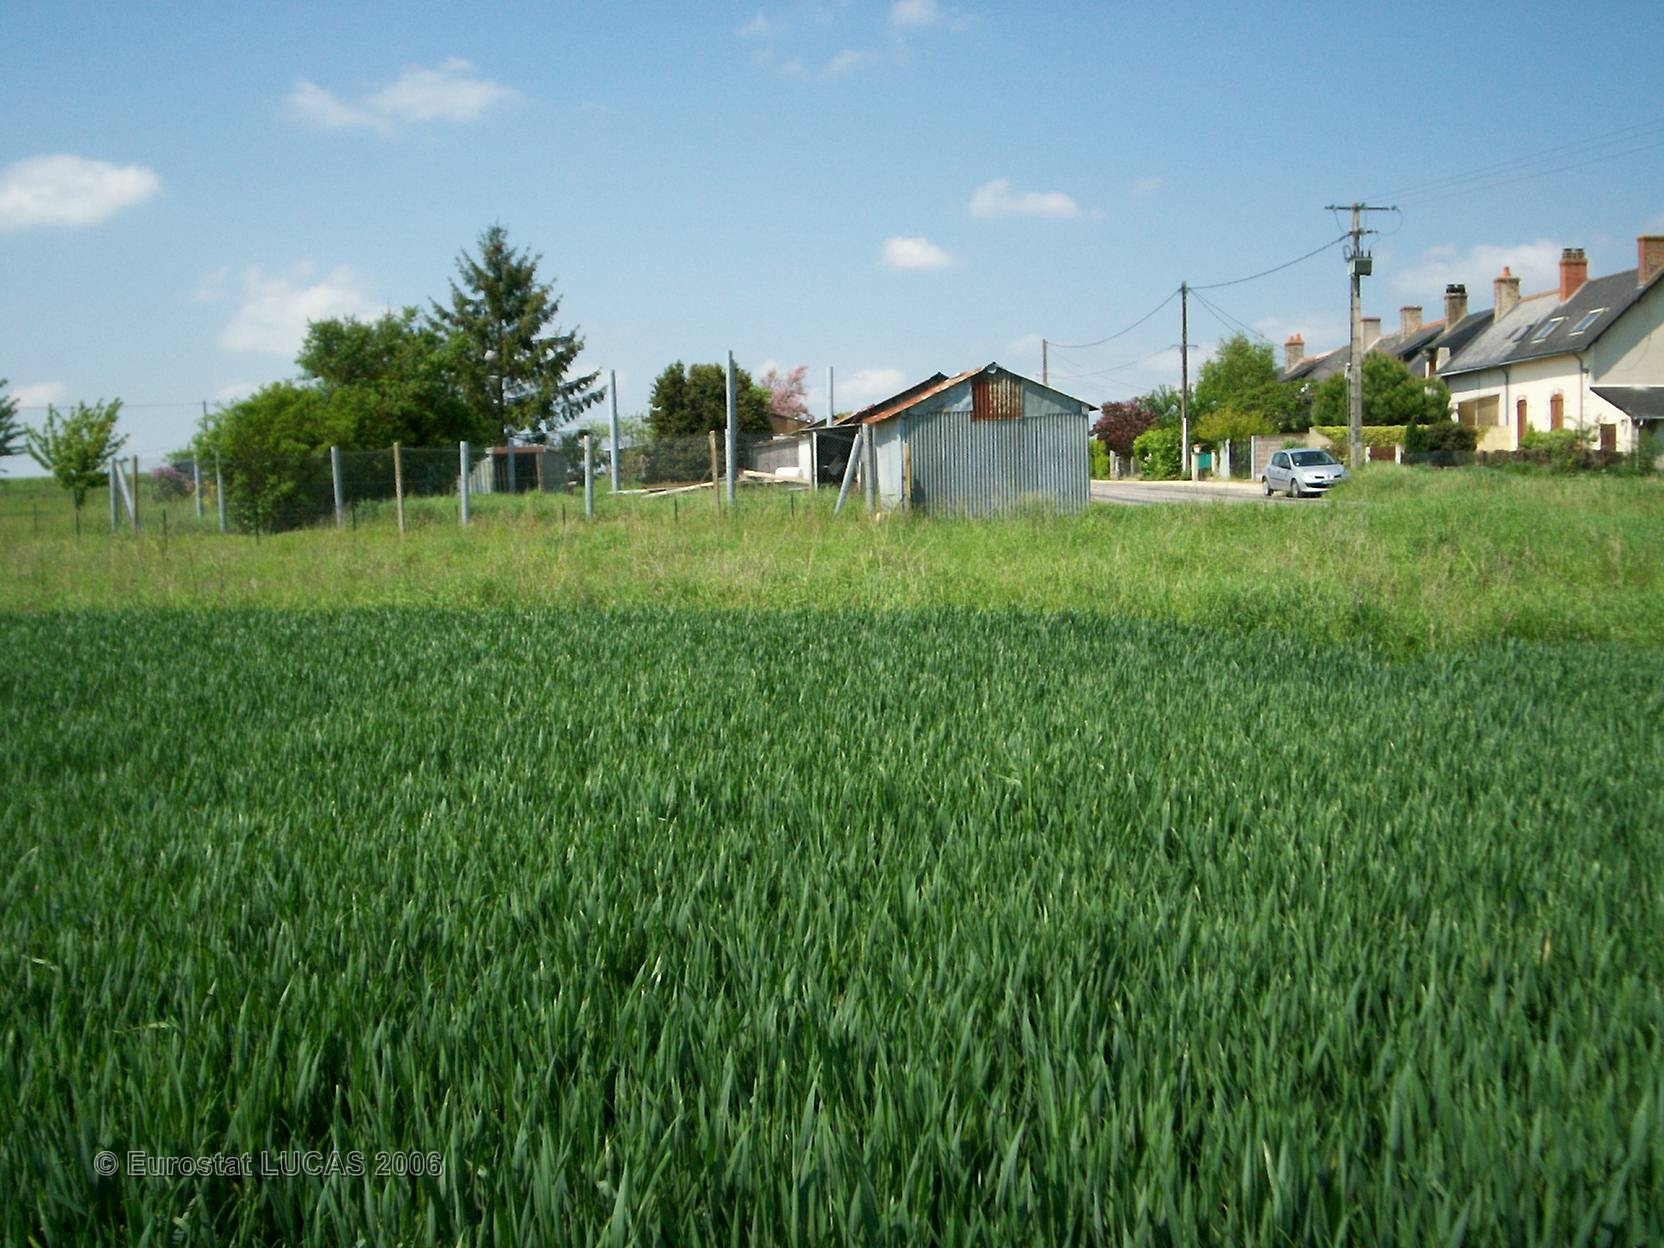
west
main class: Cropland
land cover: Common wheat
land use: Agriculture (excluding fallow land and kitchen gardens)
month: May
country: FR
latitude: 47.4465
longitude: 0.2557
